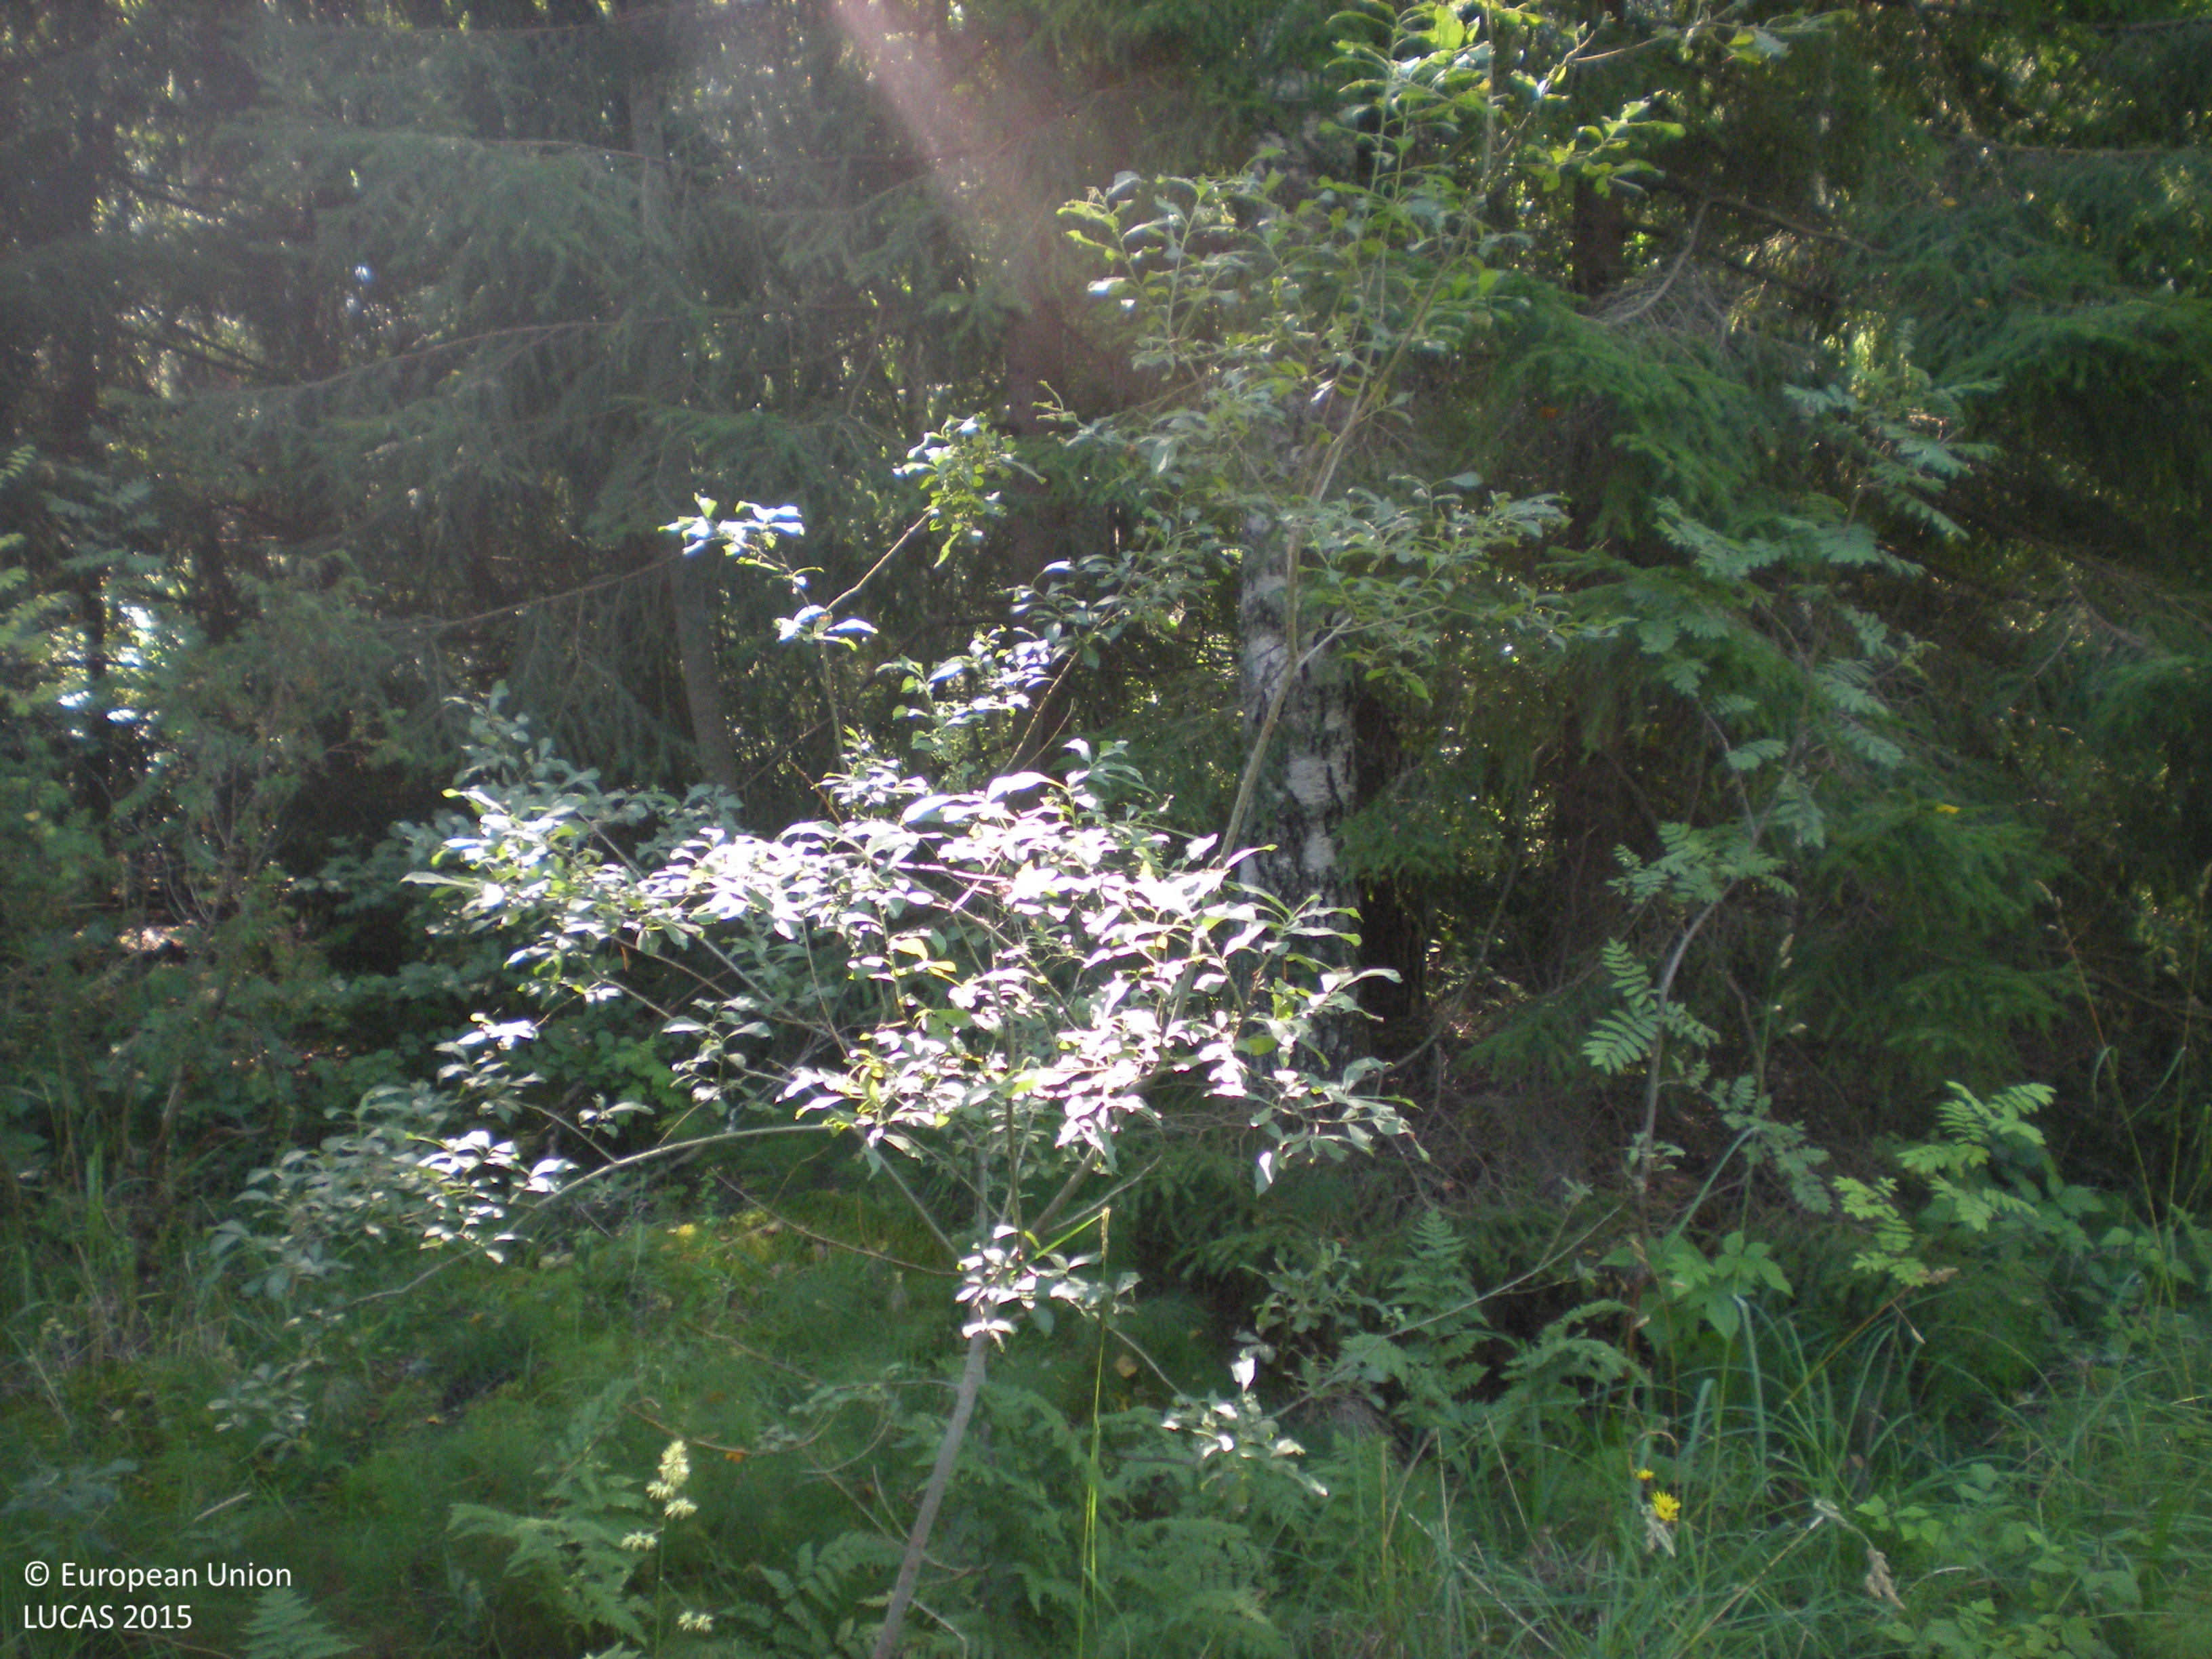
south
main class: Woodland
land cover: Spruce dominated mixed woodland
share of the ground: 50 - 75 %
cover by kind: broadleaved forest trees 35 %, herbaceous plants 30 %, coniferous forest trees 25 %, shrubs 10 %
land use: Forestry
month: August
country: SE
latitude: 60.6293
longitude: 16.8429
